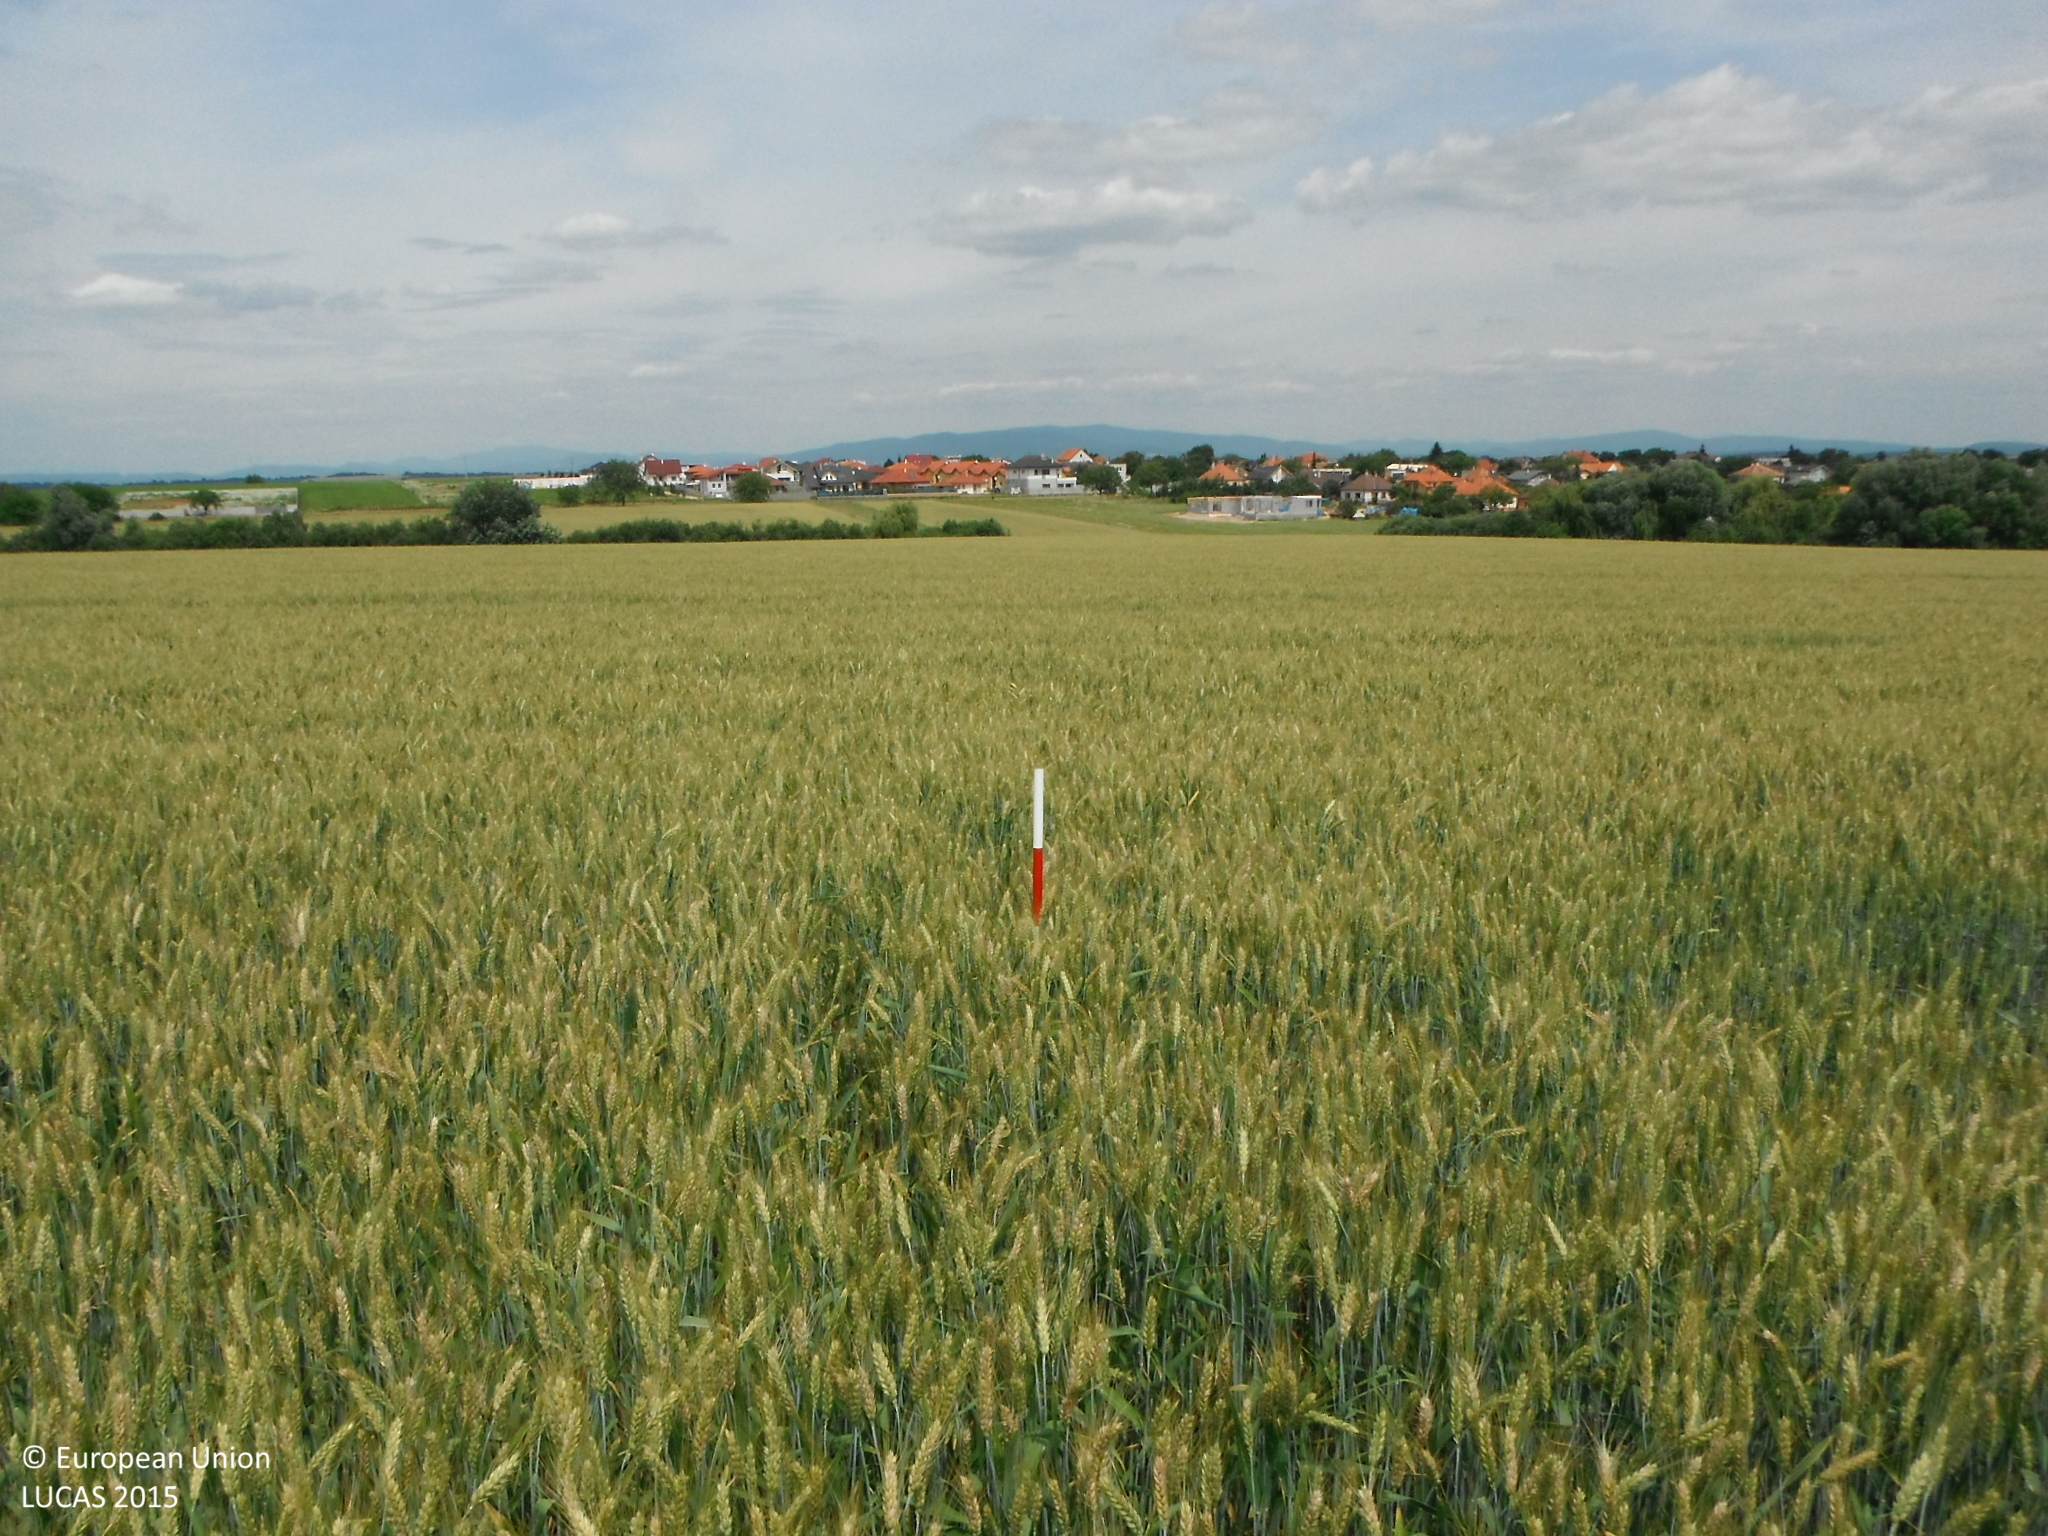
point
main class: Cropland
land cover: Common wheat
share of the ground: > 75 %
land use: Agriculture (excluding fallow land and kitchen gardens)
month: June
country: SK
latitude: 48.2759
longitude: 18.2475
